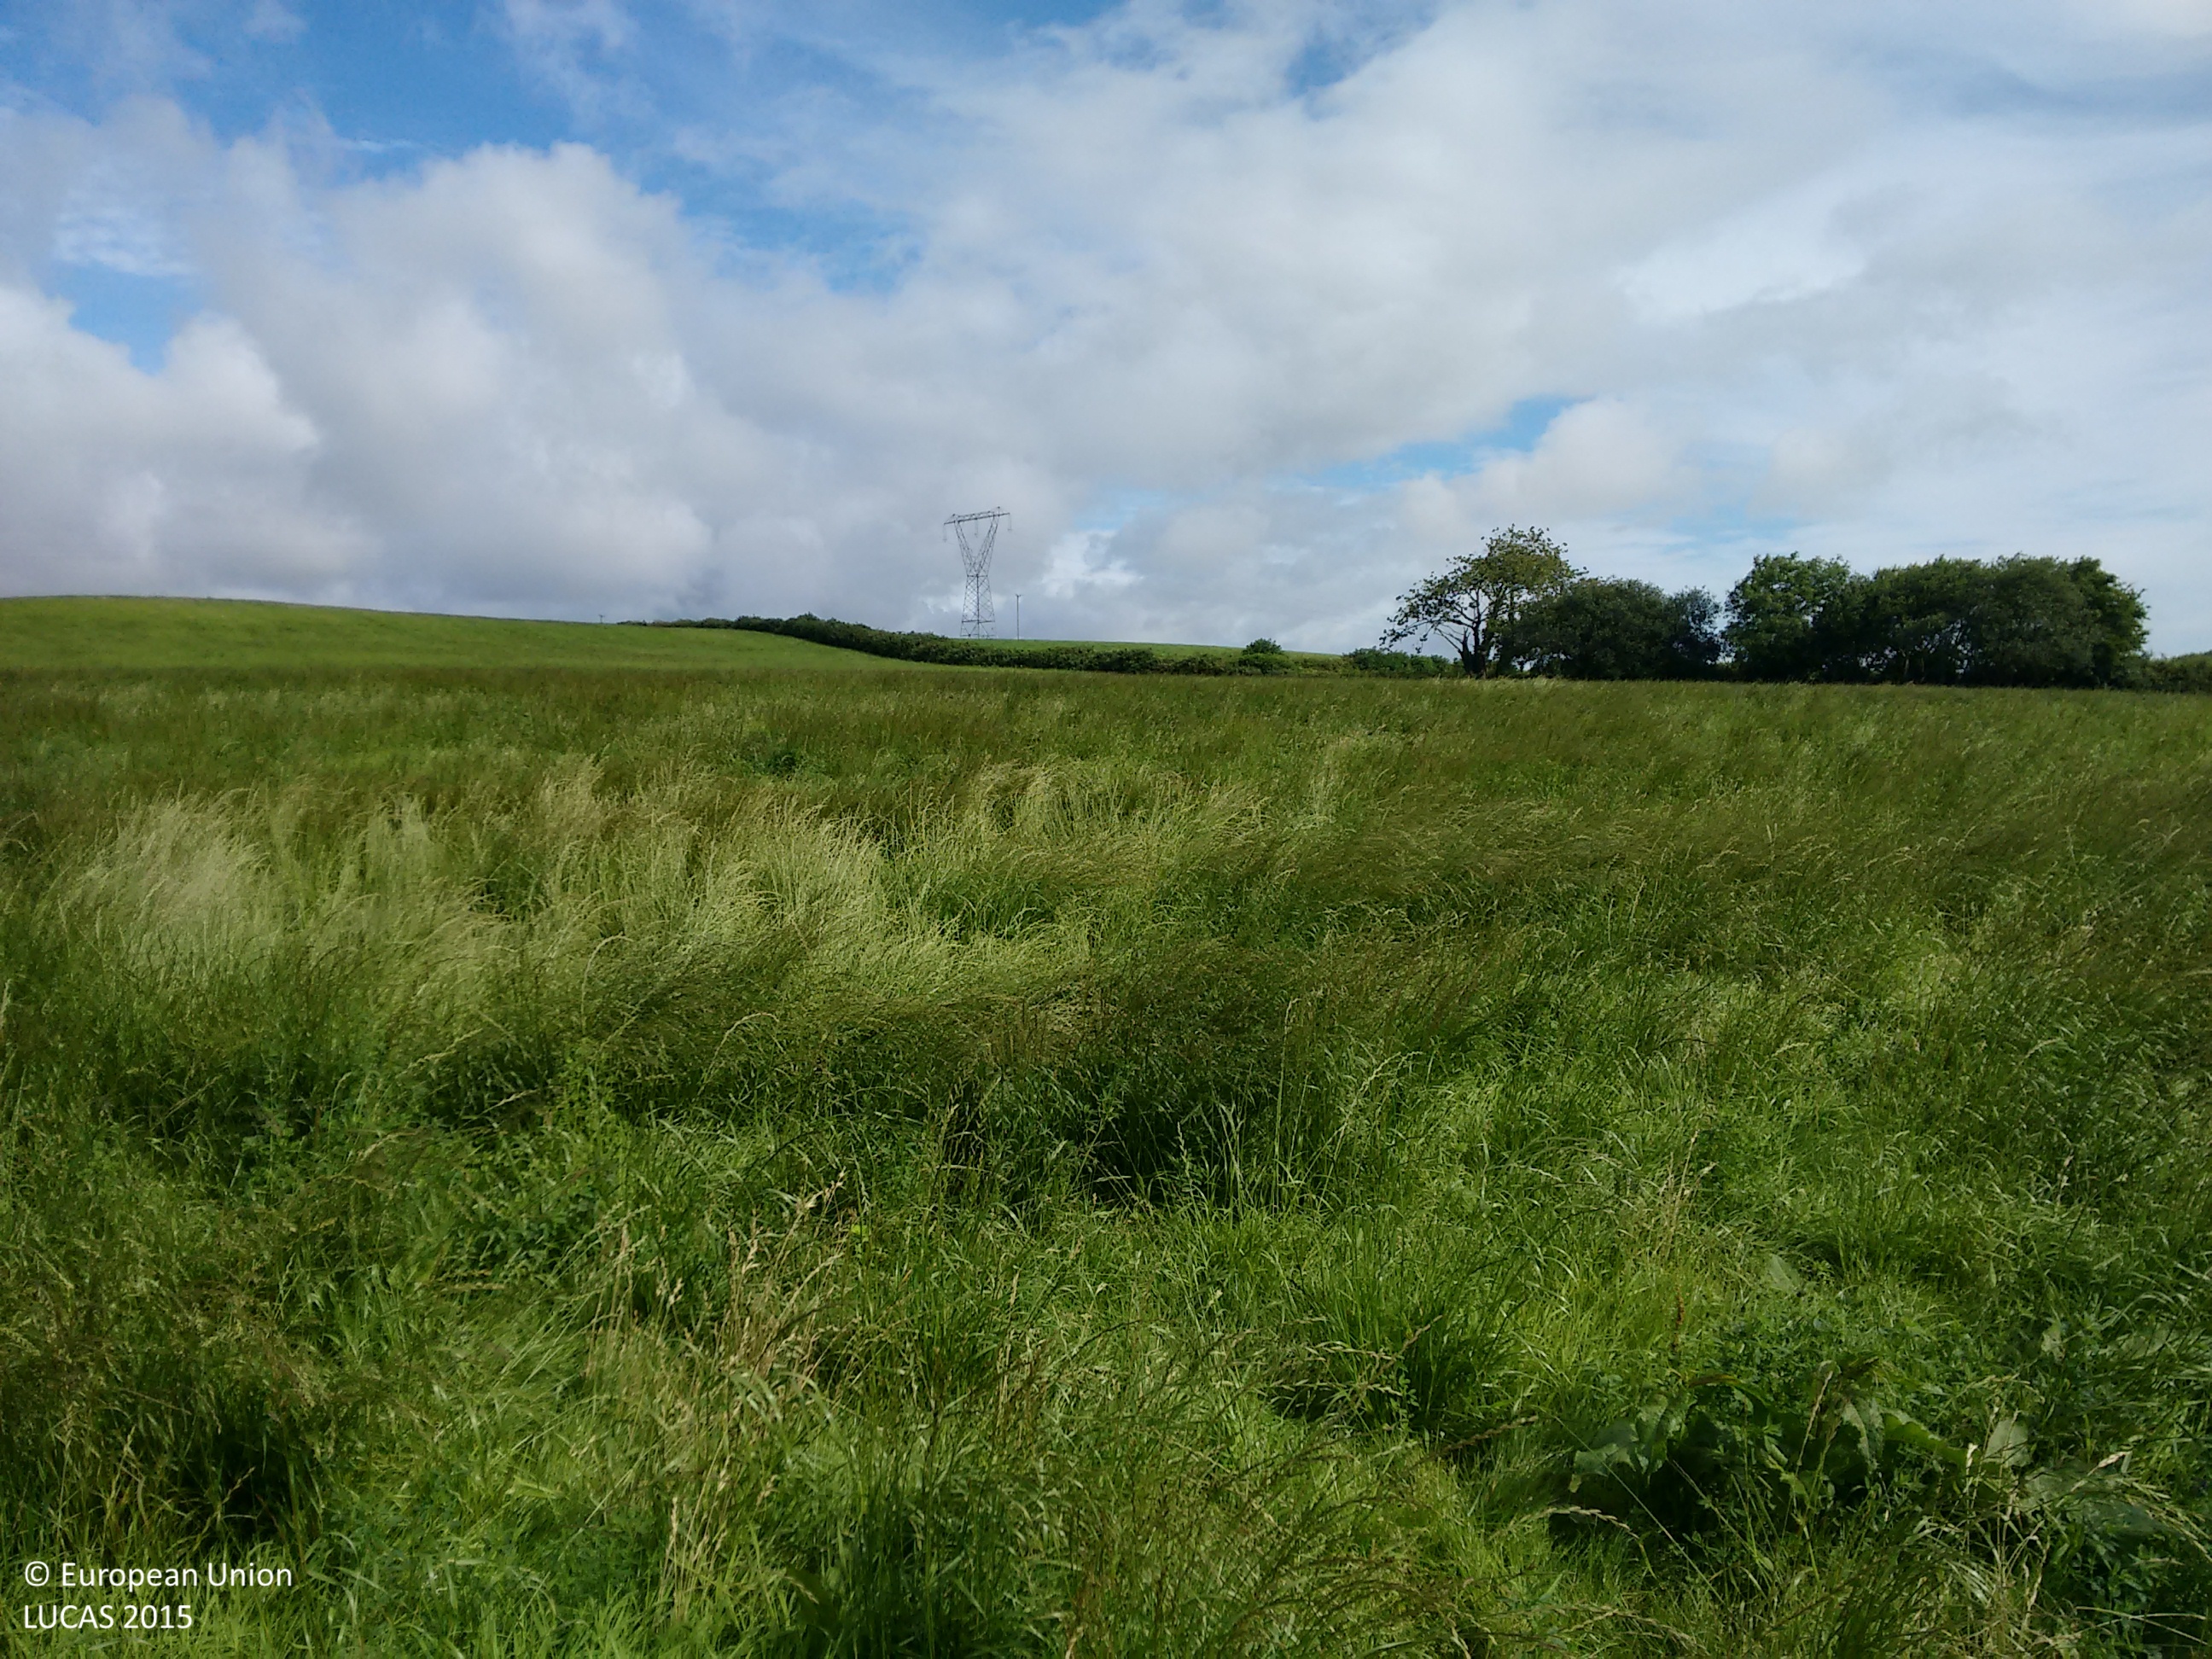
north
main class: Grassland
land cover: Grassland without tree/shrub cover
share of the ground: > 75 %
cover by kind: herbaceous plants 100 %
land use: Agriculture (excluding fallow land and kitchen gardens)
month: August
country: IE
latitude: 52.7734
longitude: -6.2324
